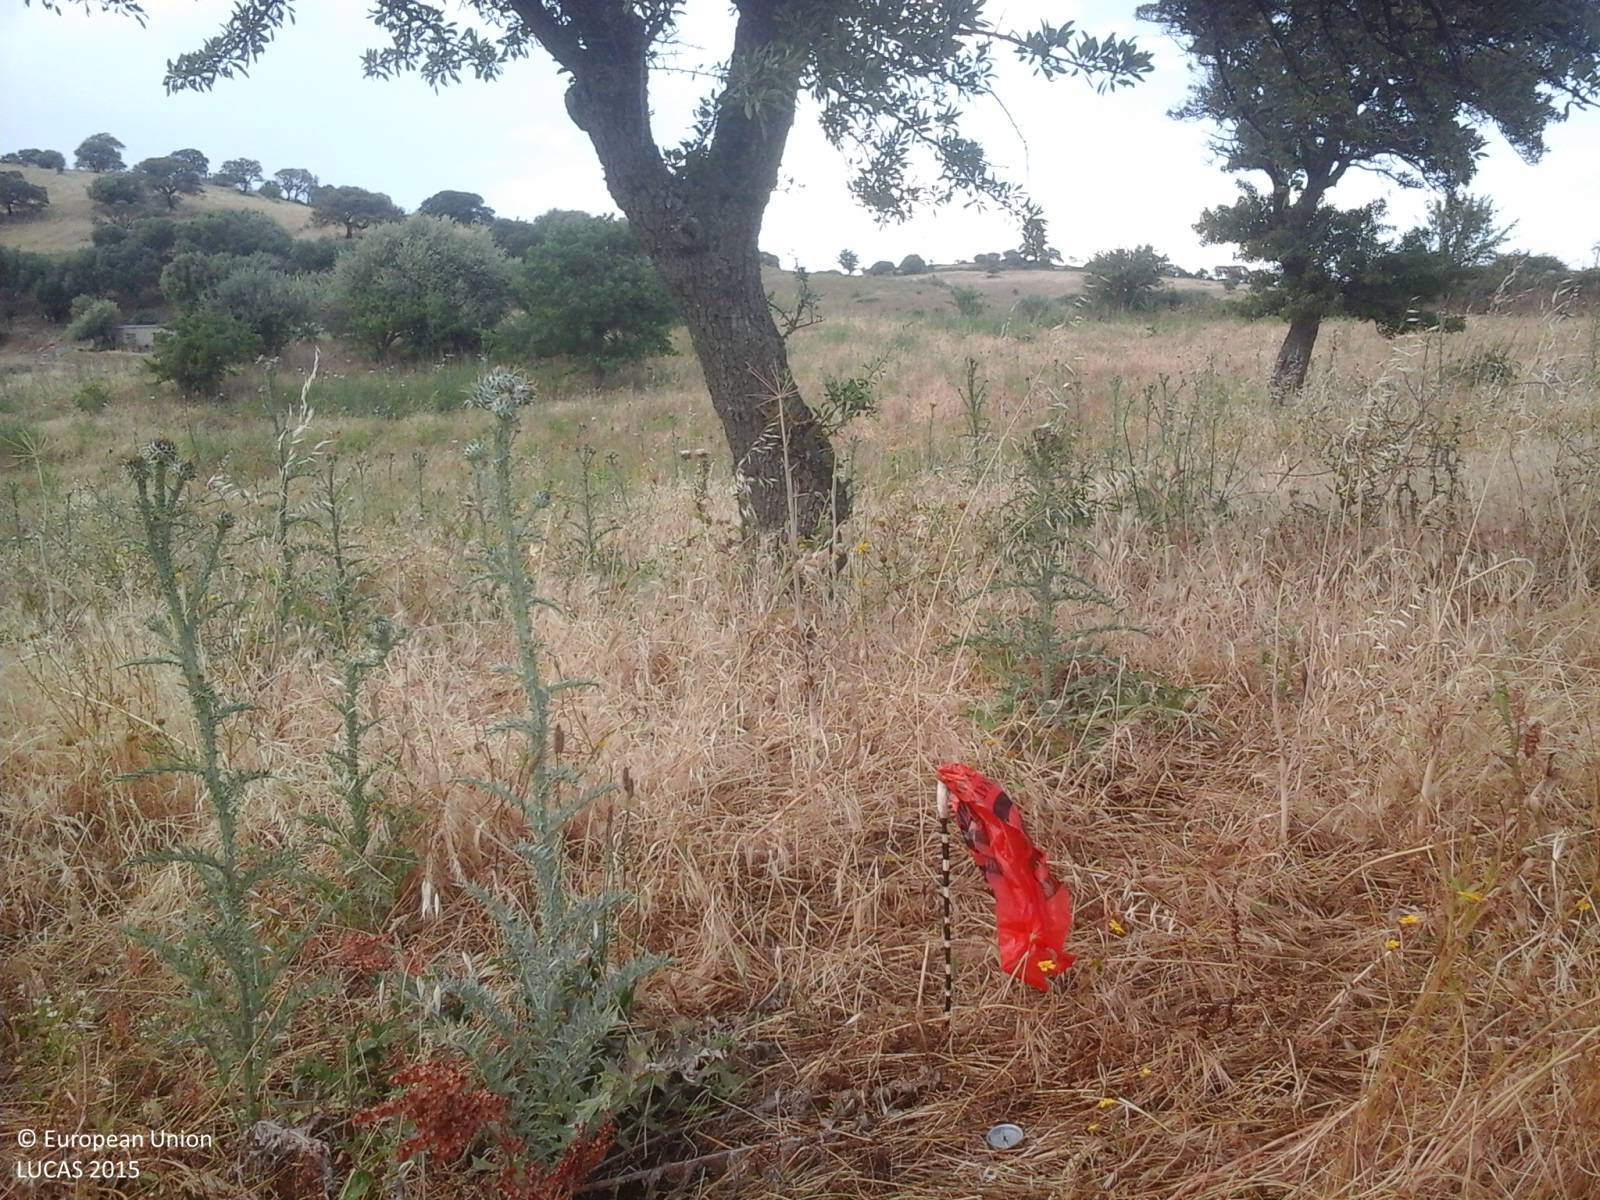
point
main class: Grassland
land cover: Grassland with sparse tree/shrub cover
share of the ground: > 75 %
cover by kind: herbaceous plants 95 %, broadleaved forest trees 5 %
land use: Agriculture (excluding fallow land and kitchen gardens)
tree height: > 5 m
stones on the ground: < 10 %
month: June
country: IT
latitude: 40.5010
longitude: 9.4247
